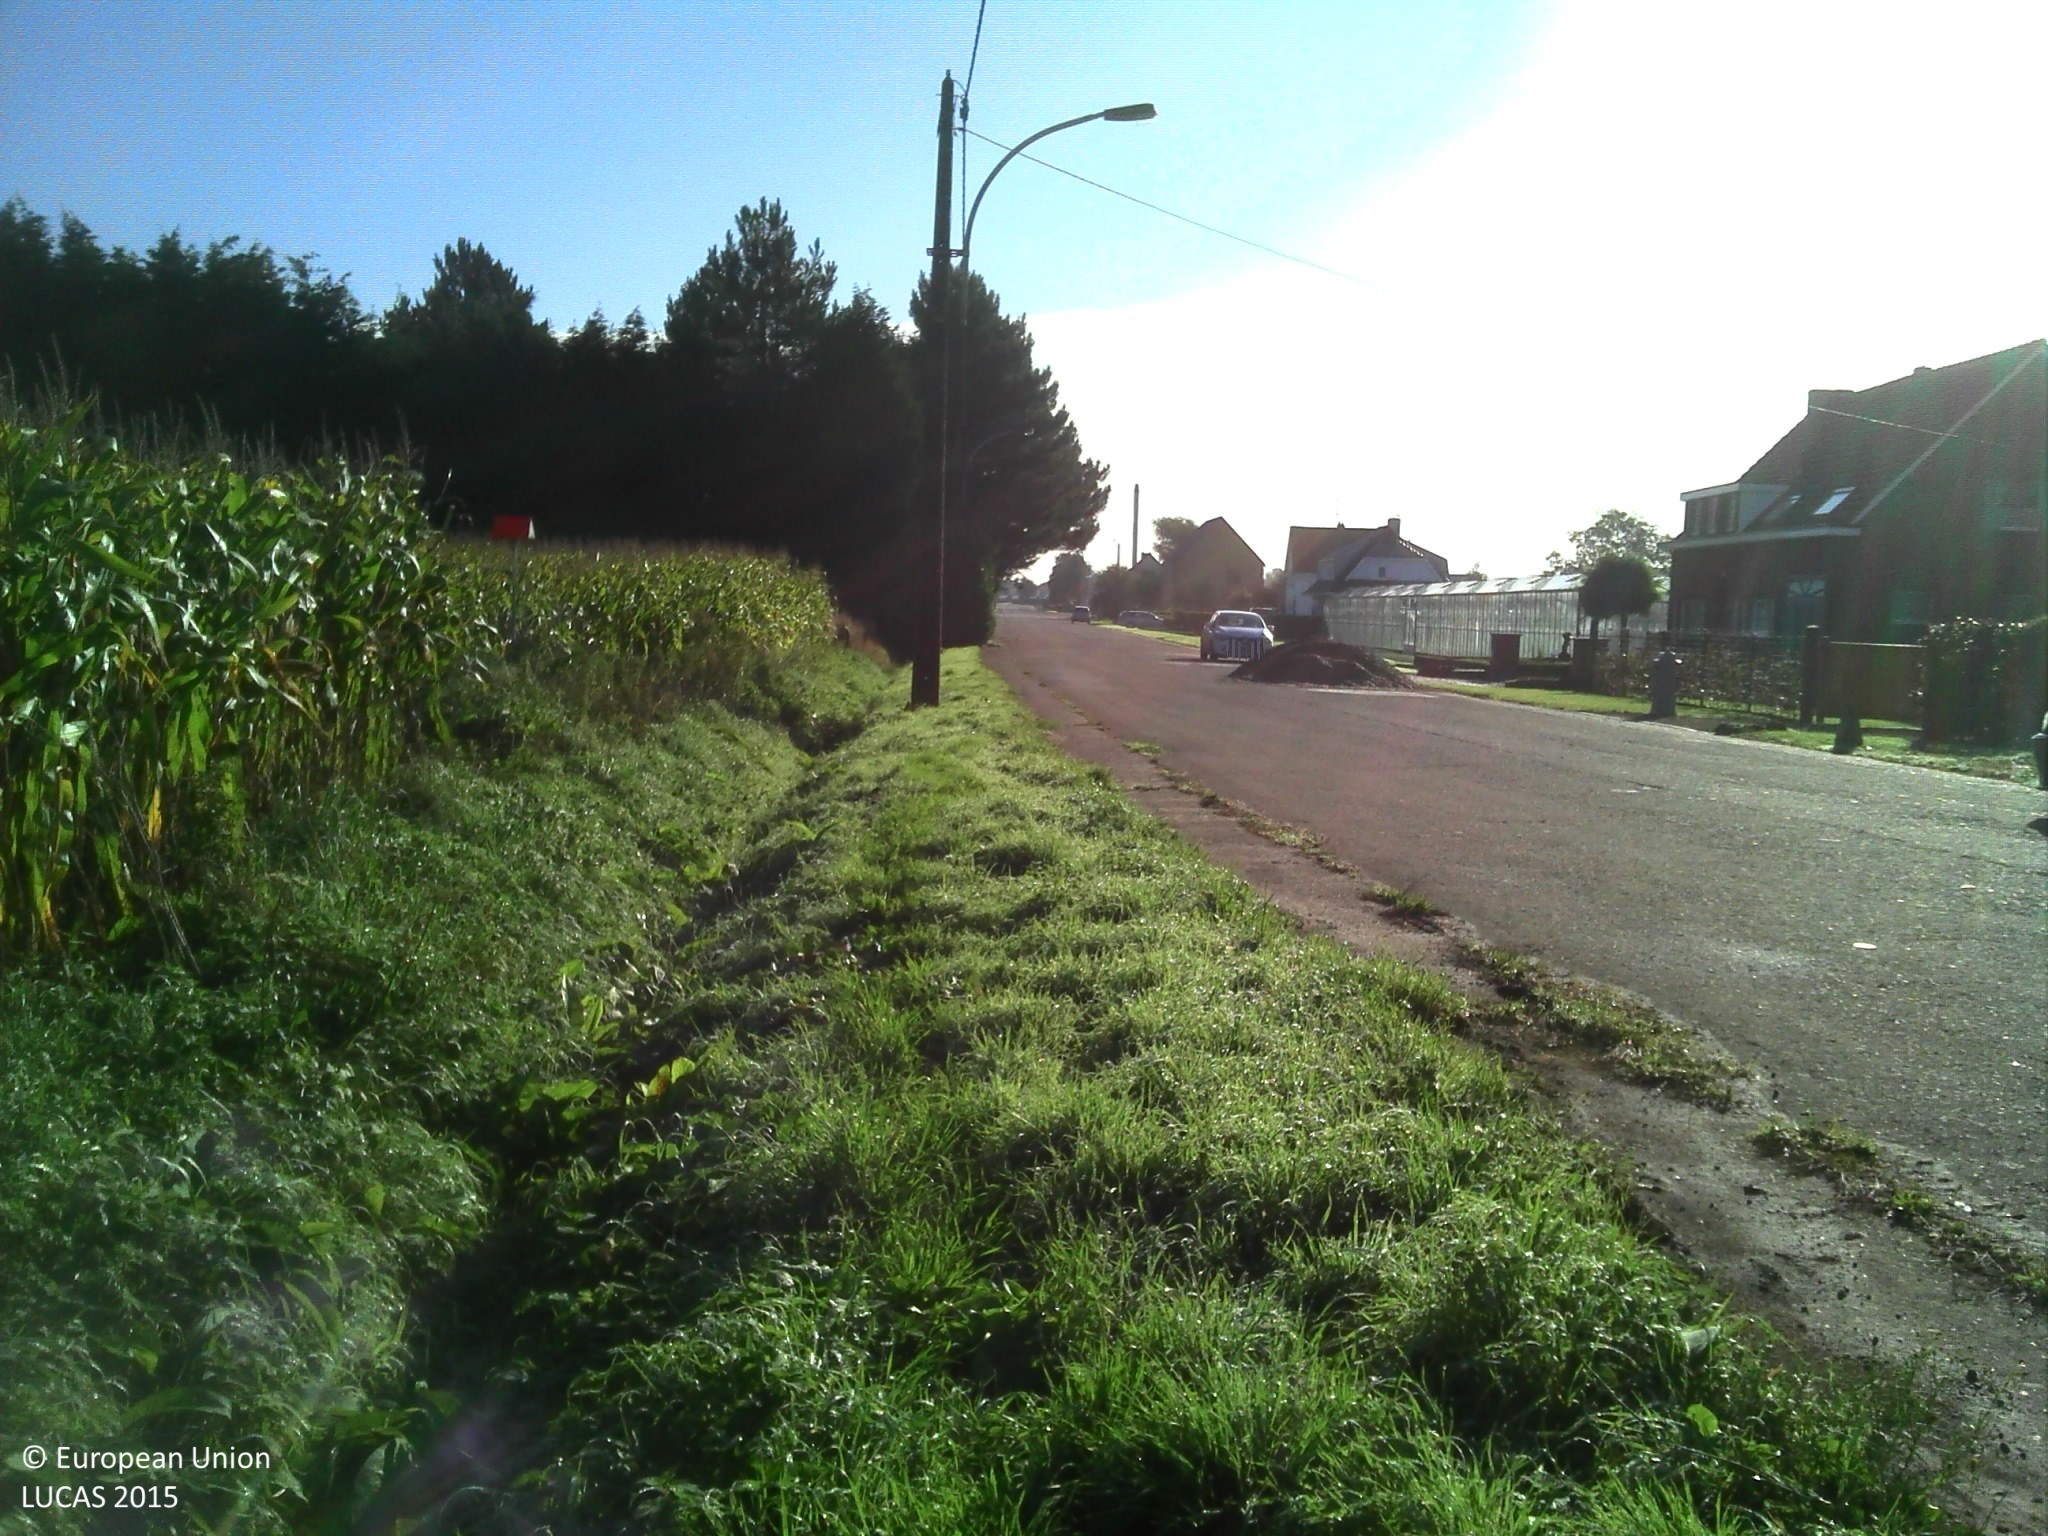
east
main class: Cropland
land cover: Maize
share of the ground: > 75 %
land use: Agriculture (excluding fallow land and kitchen gardens)
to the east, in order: Maize; Ditches and canals; Fences; Grassland without tree/shrub cover; Artificial constructions in urban areas; Grassland without tree/shrub cover; Artificial constructions in urban areas
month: September
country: BE
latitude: 51.0940
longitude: 4.4412
